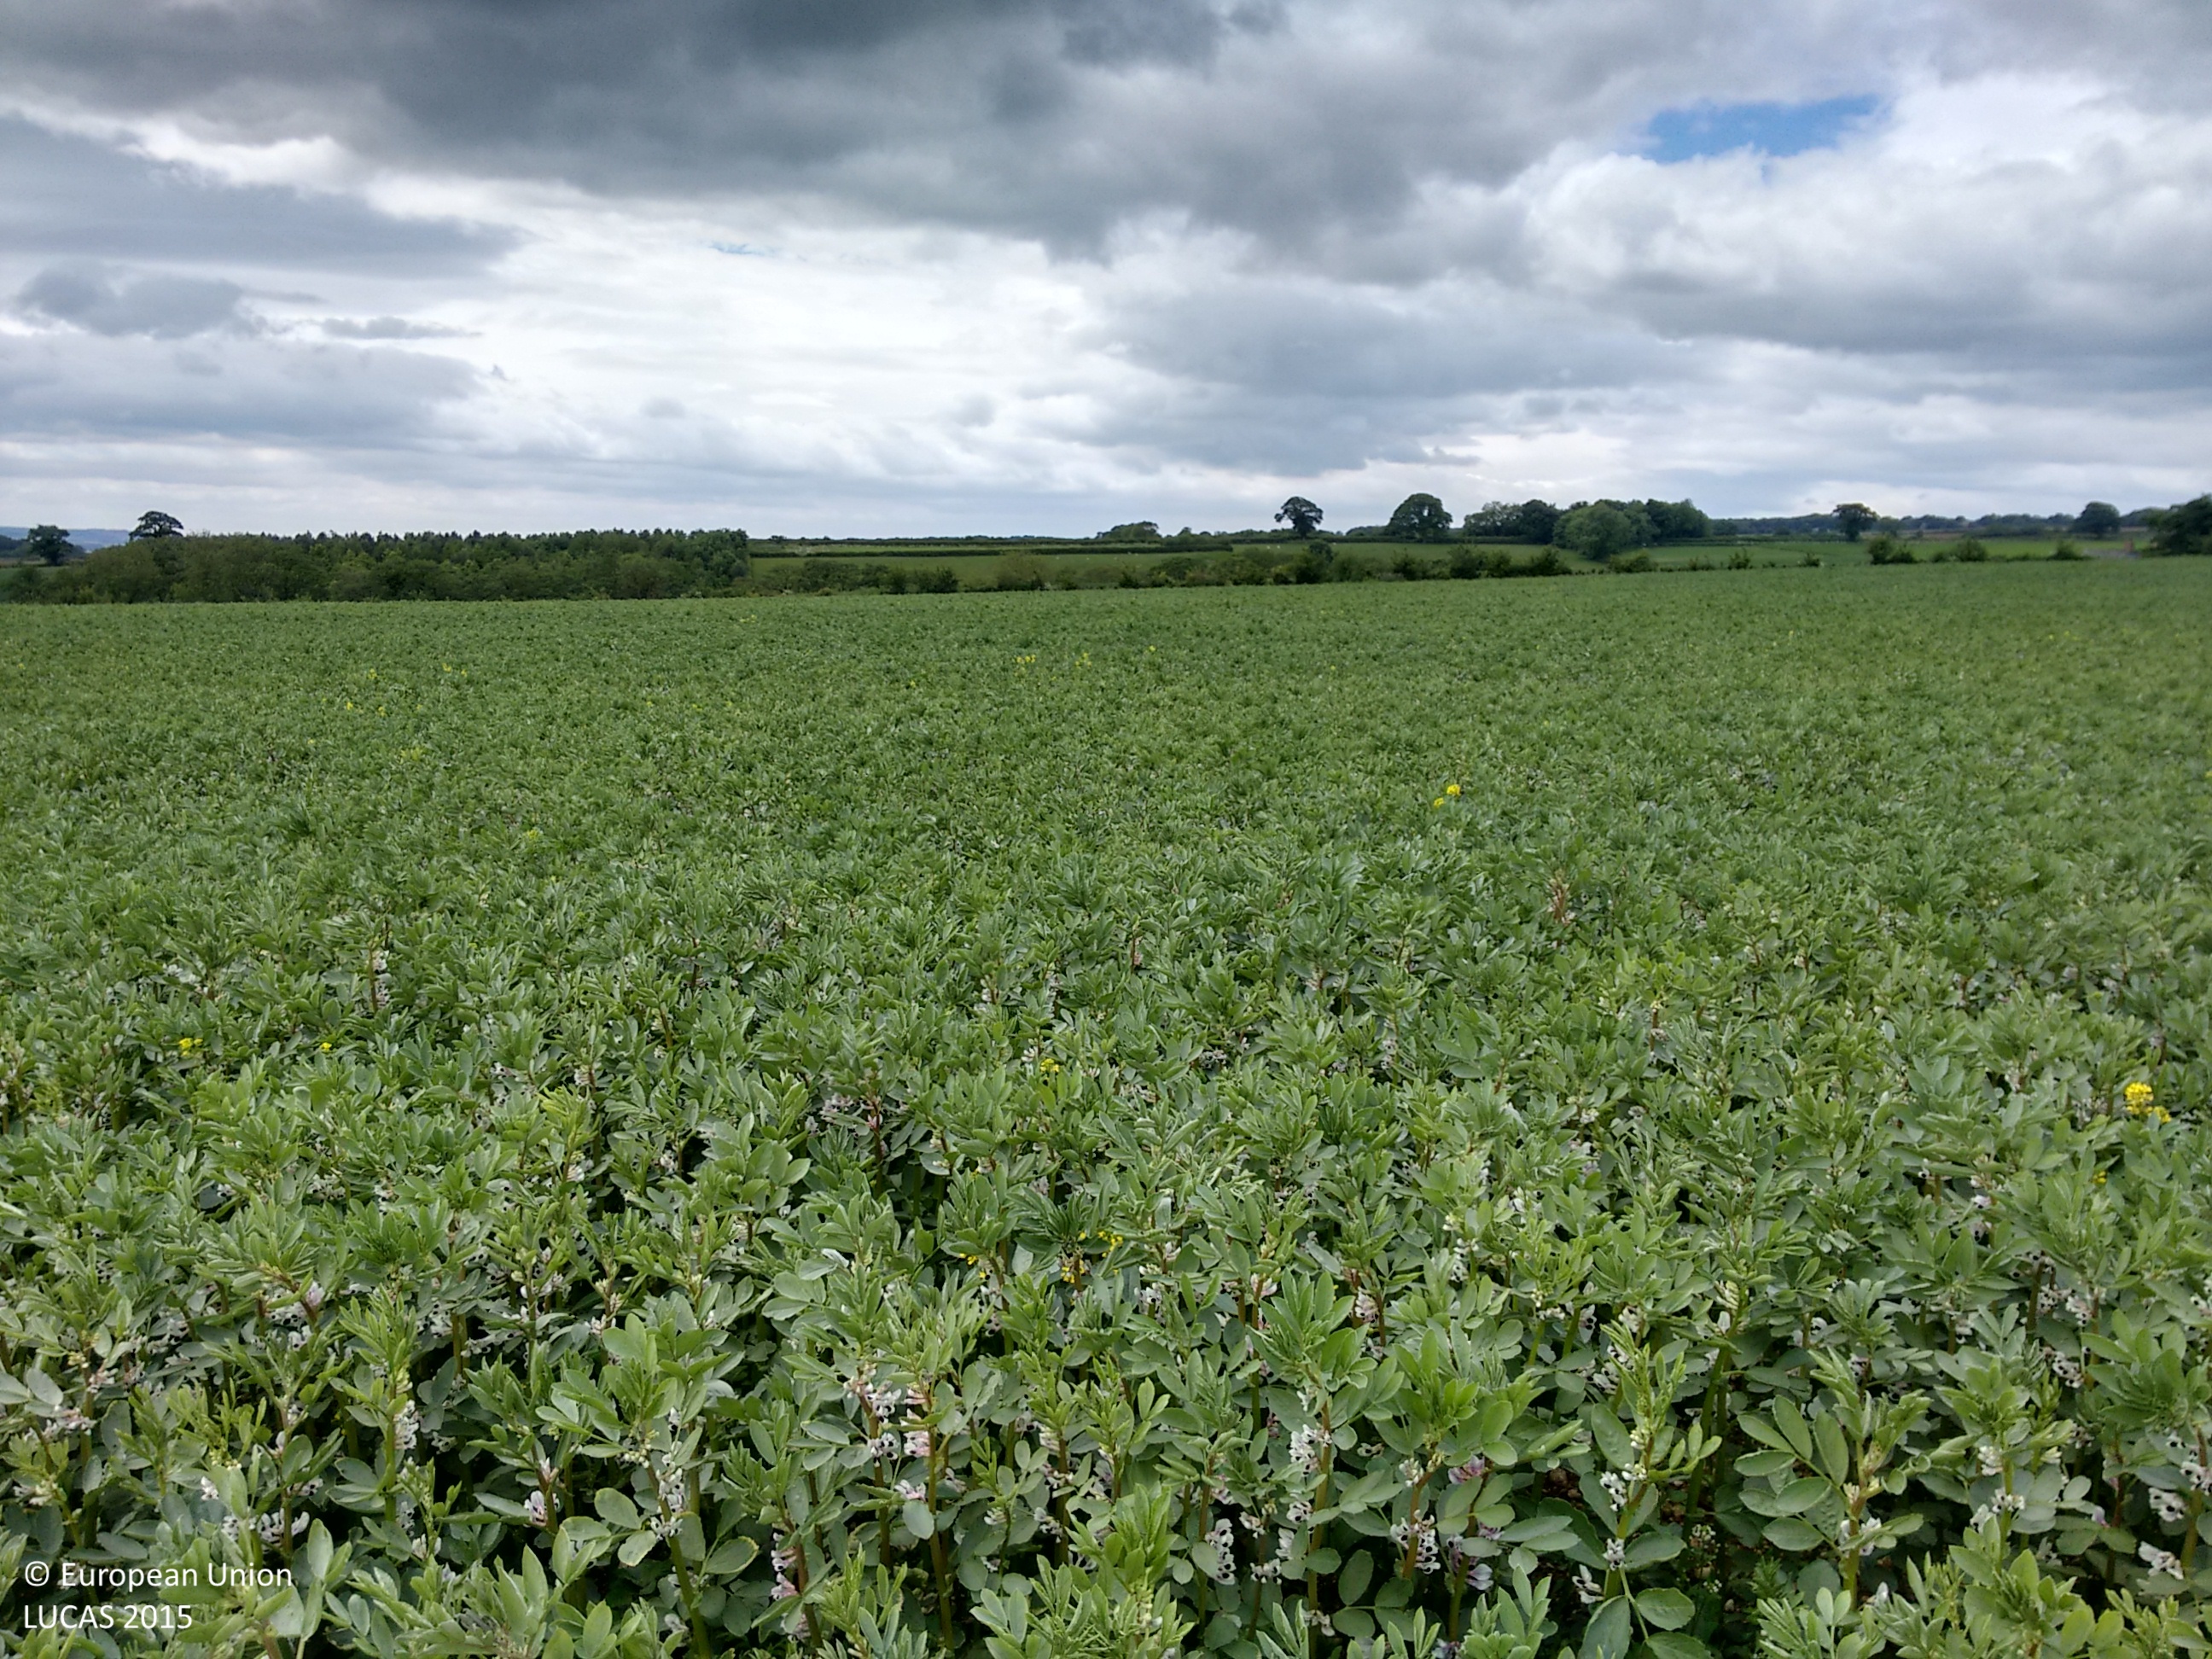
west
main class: Cropland
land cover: Dry pulses
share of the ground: > 75 %
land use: Agriculture (excluding fallow land and kitchen gardens)
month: June
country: GB
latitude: 54.2484
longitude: -0.5185
